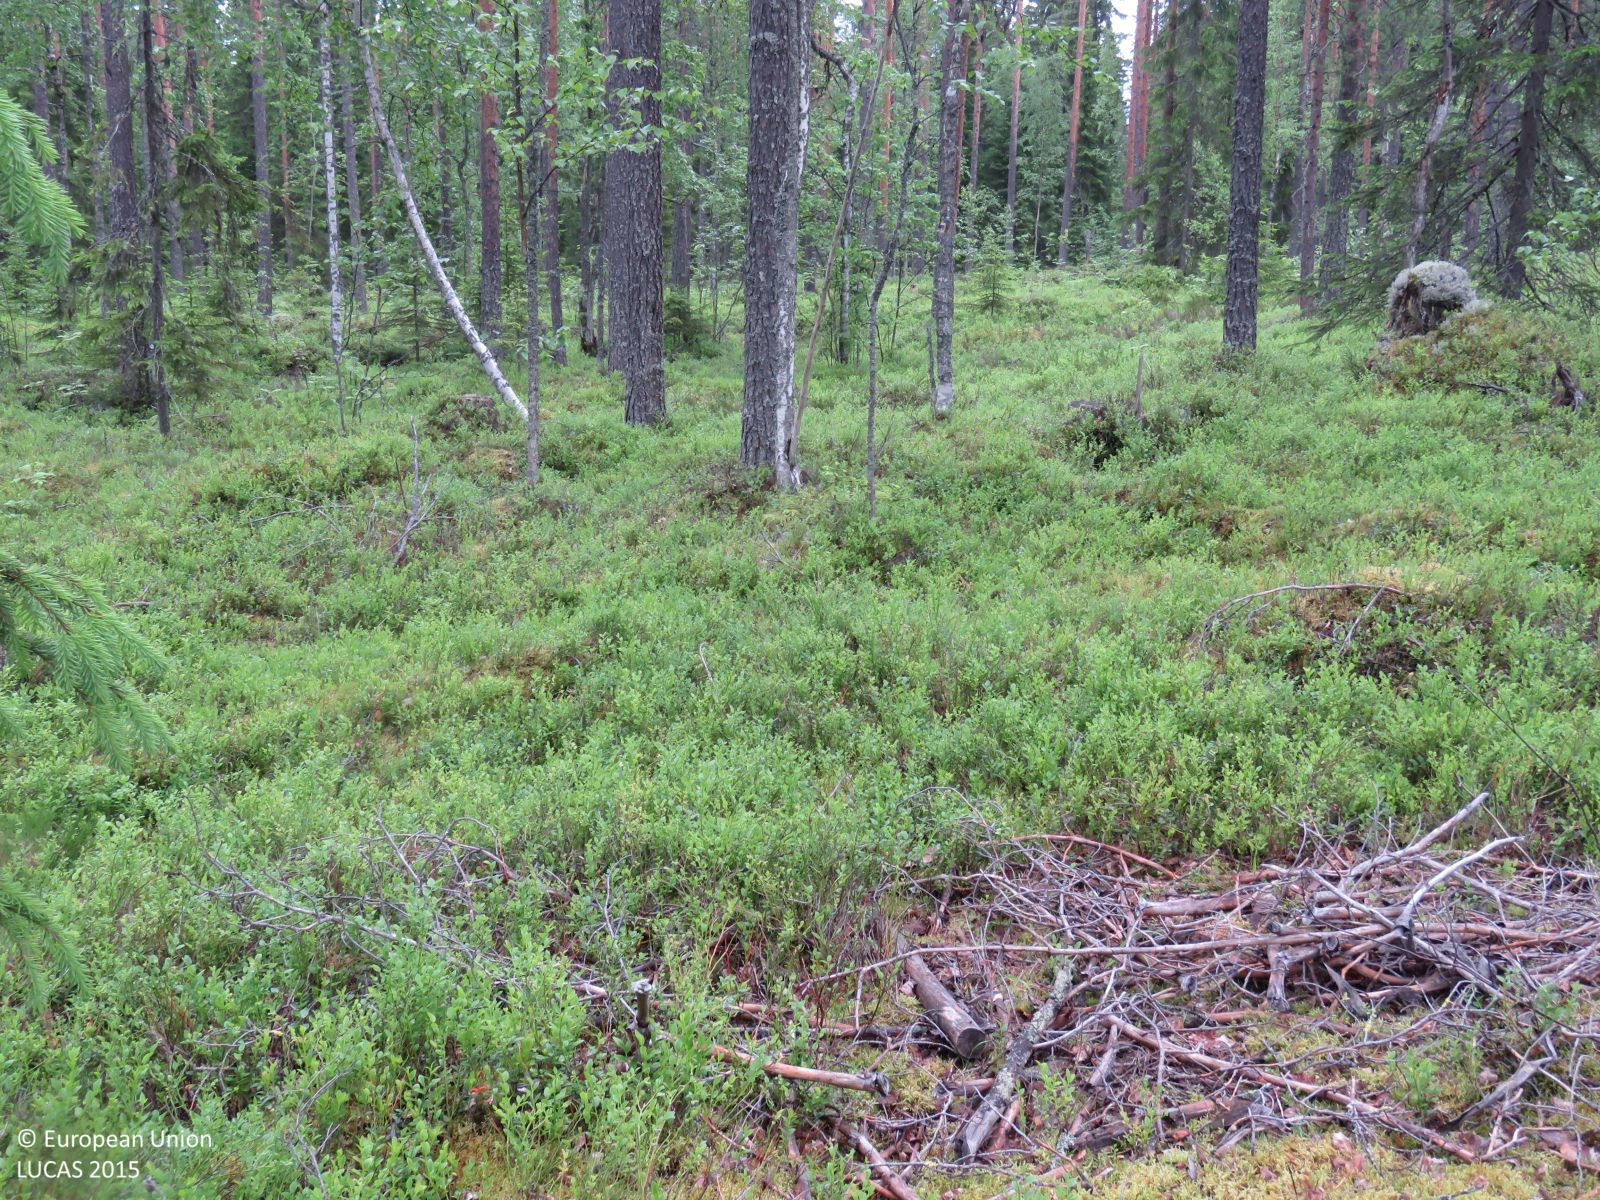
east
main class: Woodland
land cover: Pine dominated coniferous woodland
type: boreal forest
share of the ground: > 75 %
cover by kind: coniferous forest trees 60 %, shrubs 20 %, broadleaved forest trees 15 %, herbaceous plants 5 %
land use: Forestry
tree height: > 5 m
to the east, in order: Pine dominated coniferous woodland; Spruce dominated coniferous woodland; Spruce dominated mixed woodland; Grass margins; Tracks; Grass margins; Spruce dominated mixed woodland; Spruce dominated coniferous woodland
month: June
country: FI
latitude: 64.1163
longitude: 26.6933
